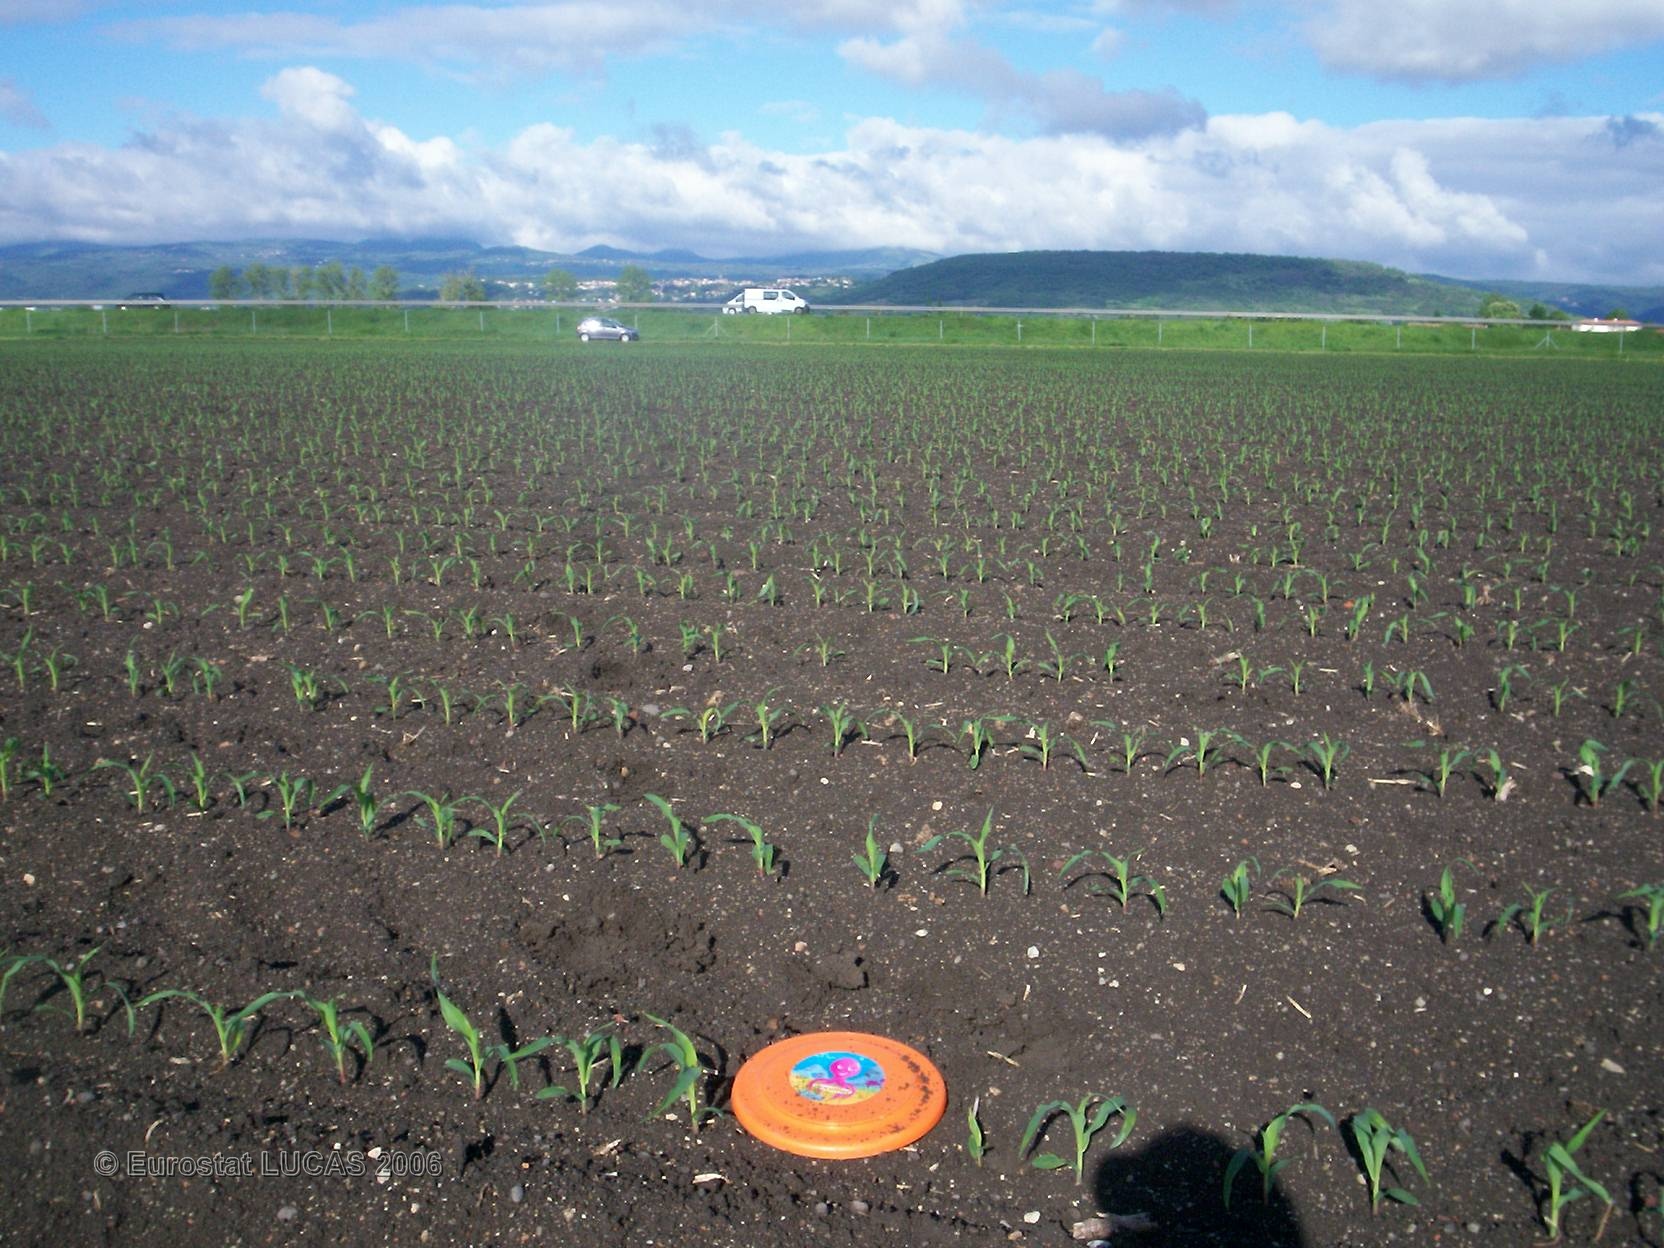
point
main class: Cropland
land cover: Maize
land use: Agriculture (excluding fallow land and kitchen gardens)
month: May
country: FR
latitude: 45.8610
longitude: 3.1603
